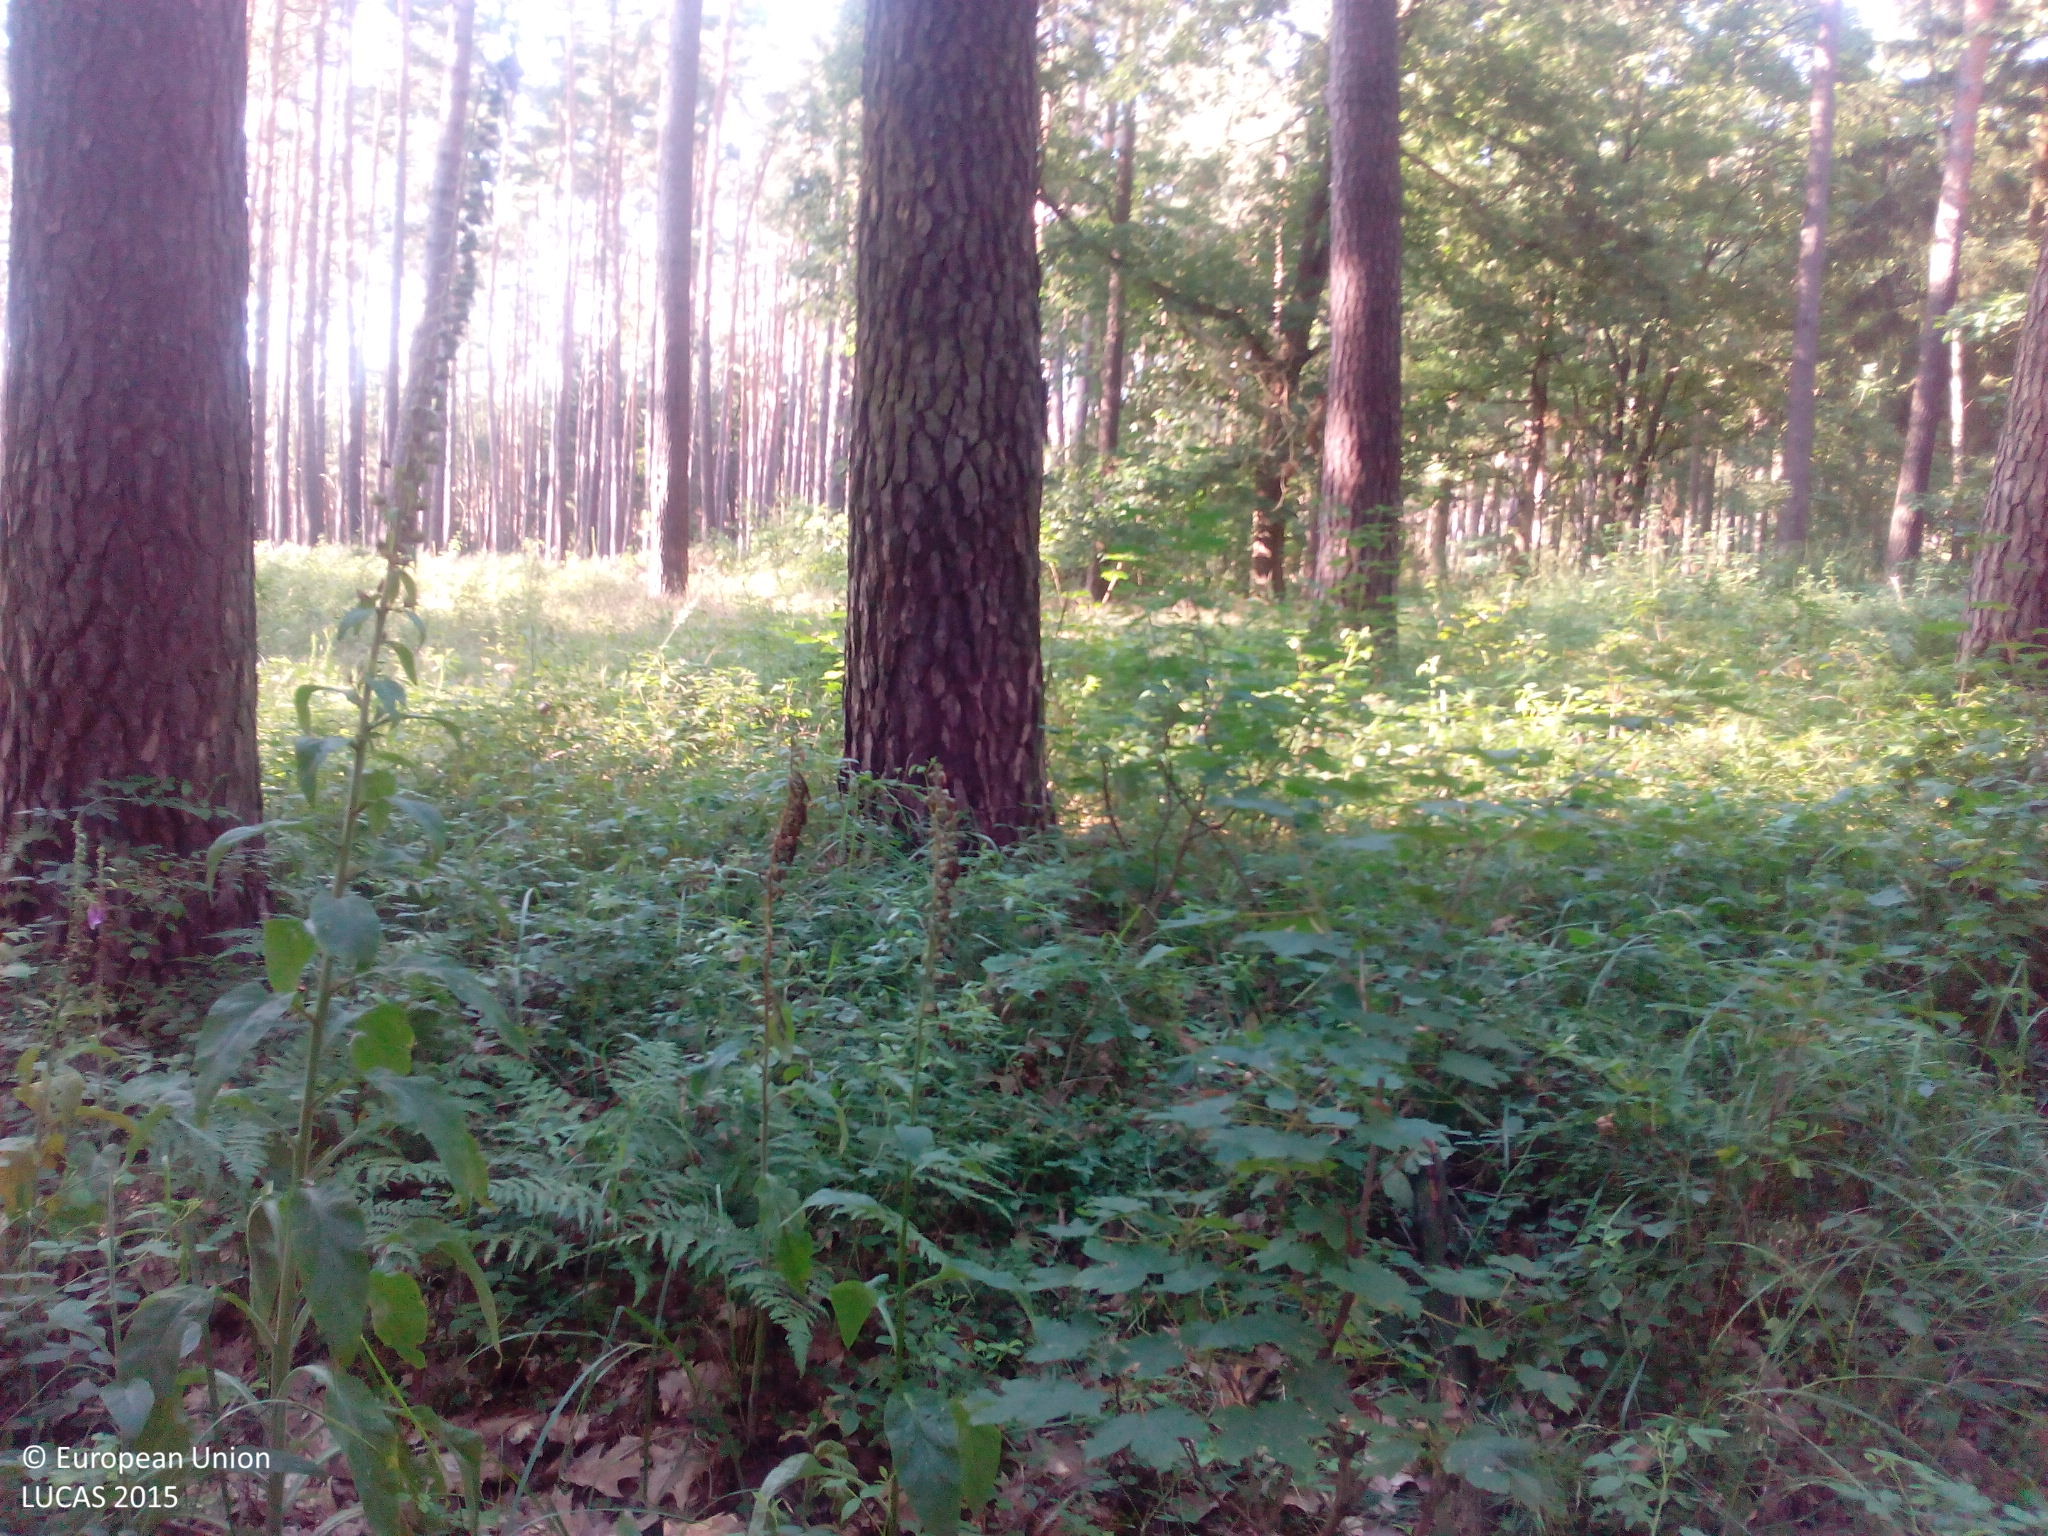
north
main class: Woodland
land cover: Pine dominated mixed woodland
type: hemiboreal forest and nemoral coniferous forest and mixed broadleaved-coniferous forest
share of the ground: > 75 %
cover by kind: coniferous forest trees 75 %, broadleaved forest trees 25 %
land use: Forestry
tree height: > 5 m
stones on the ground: < 10 %
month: July
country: DE
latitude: 51.9953
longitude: 12.3154
